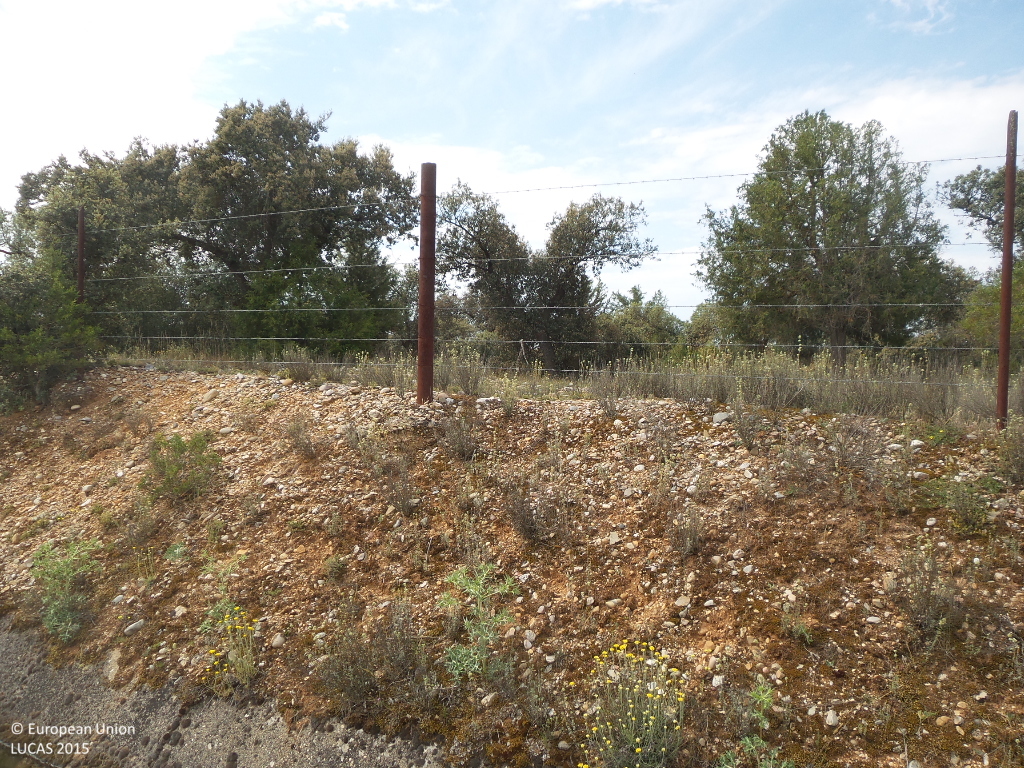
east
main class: Woodland
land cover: Broadleaved woodland
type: broadleaved evergreen forest
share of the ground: 10 - 25 %
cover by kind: herbaceous plants 40 %, shrubs 25 %, broadleaved forest trees 20 %, unconsolidated bare surface 10 %, coniferous forest trees 5 %
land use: Forestry
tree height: > 5 m
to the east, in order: Broadleaved woodland; Ditches and canals; Fences; Broadleaved woodland; Tracks; Broadleaved woodland
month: June
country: ES
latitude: 41.5258
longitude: -3.0938
